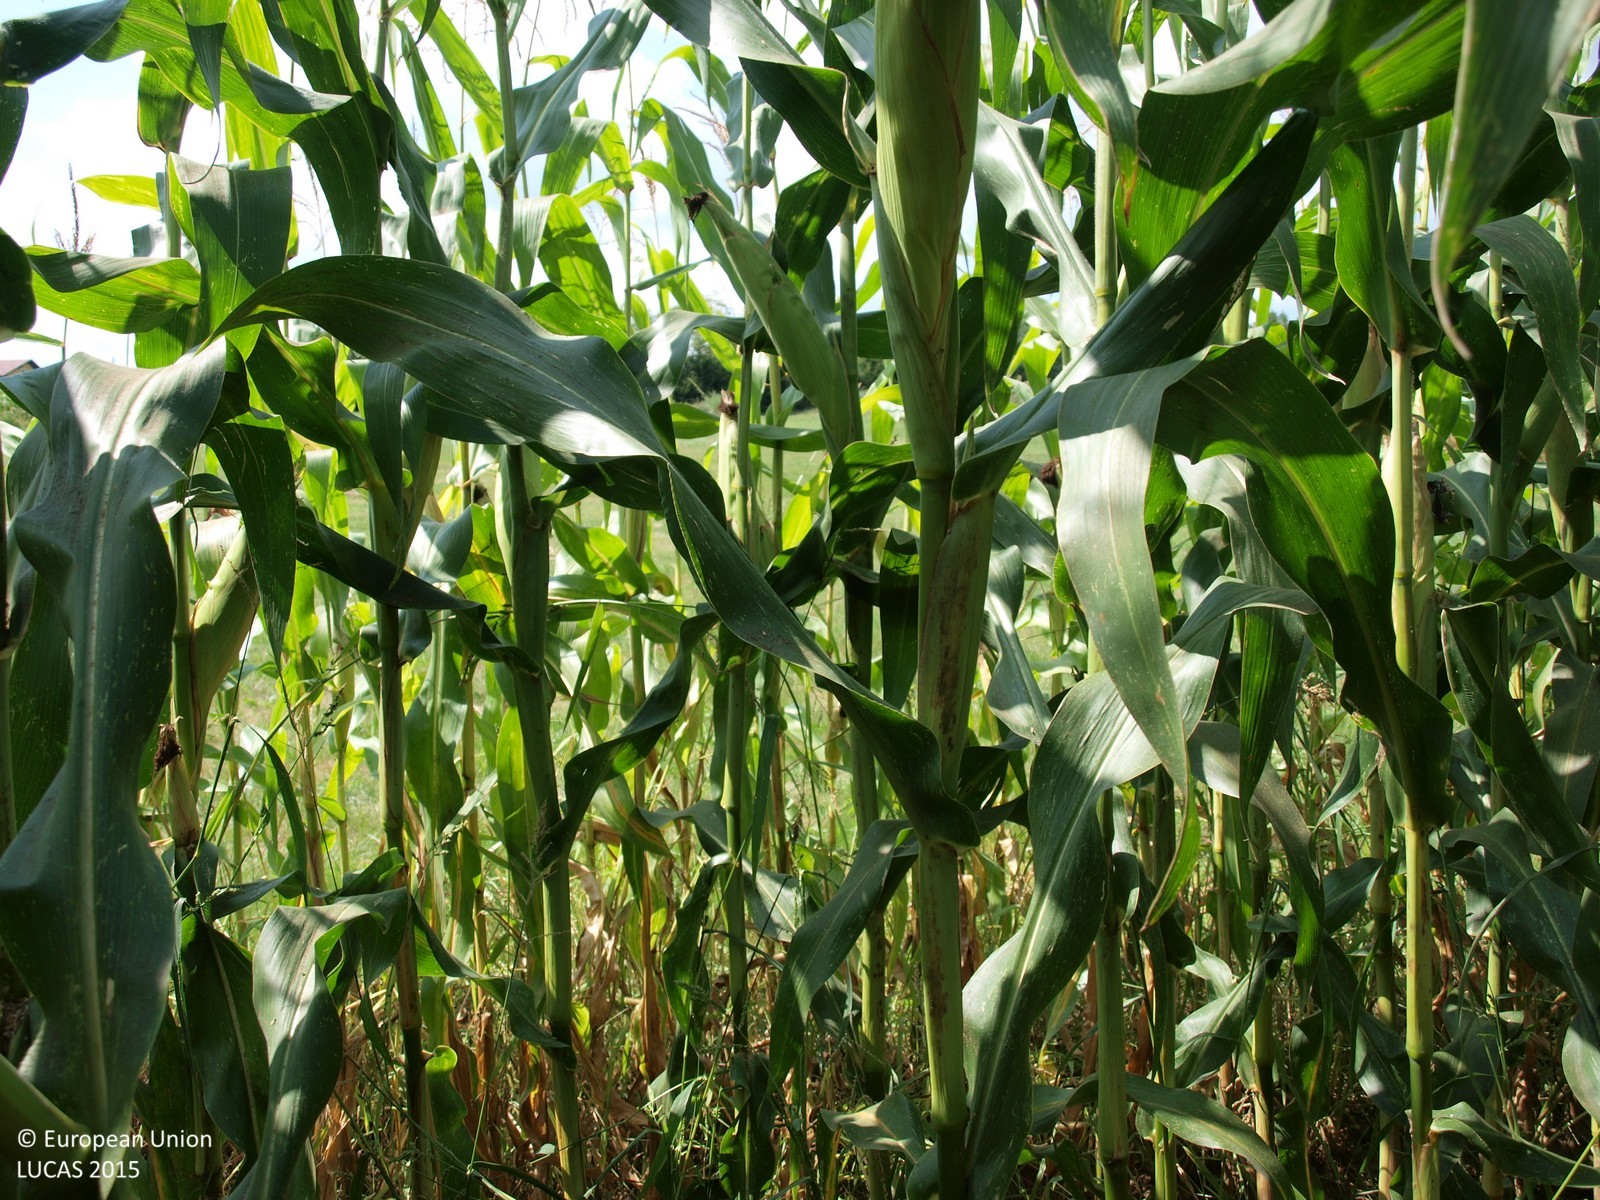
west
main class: Cropland
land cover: Maize
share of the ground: > 75 %
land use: Agriculture (excluding fallow land and kitchen gardens)
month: August
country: HR
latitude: 46.0793
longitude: 16.5301
